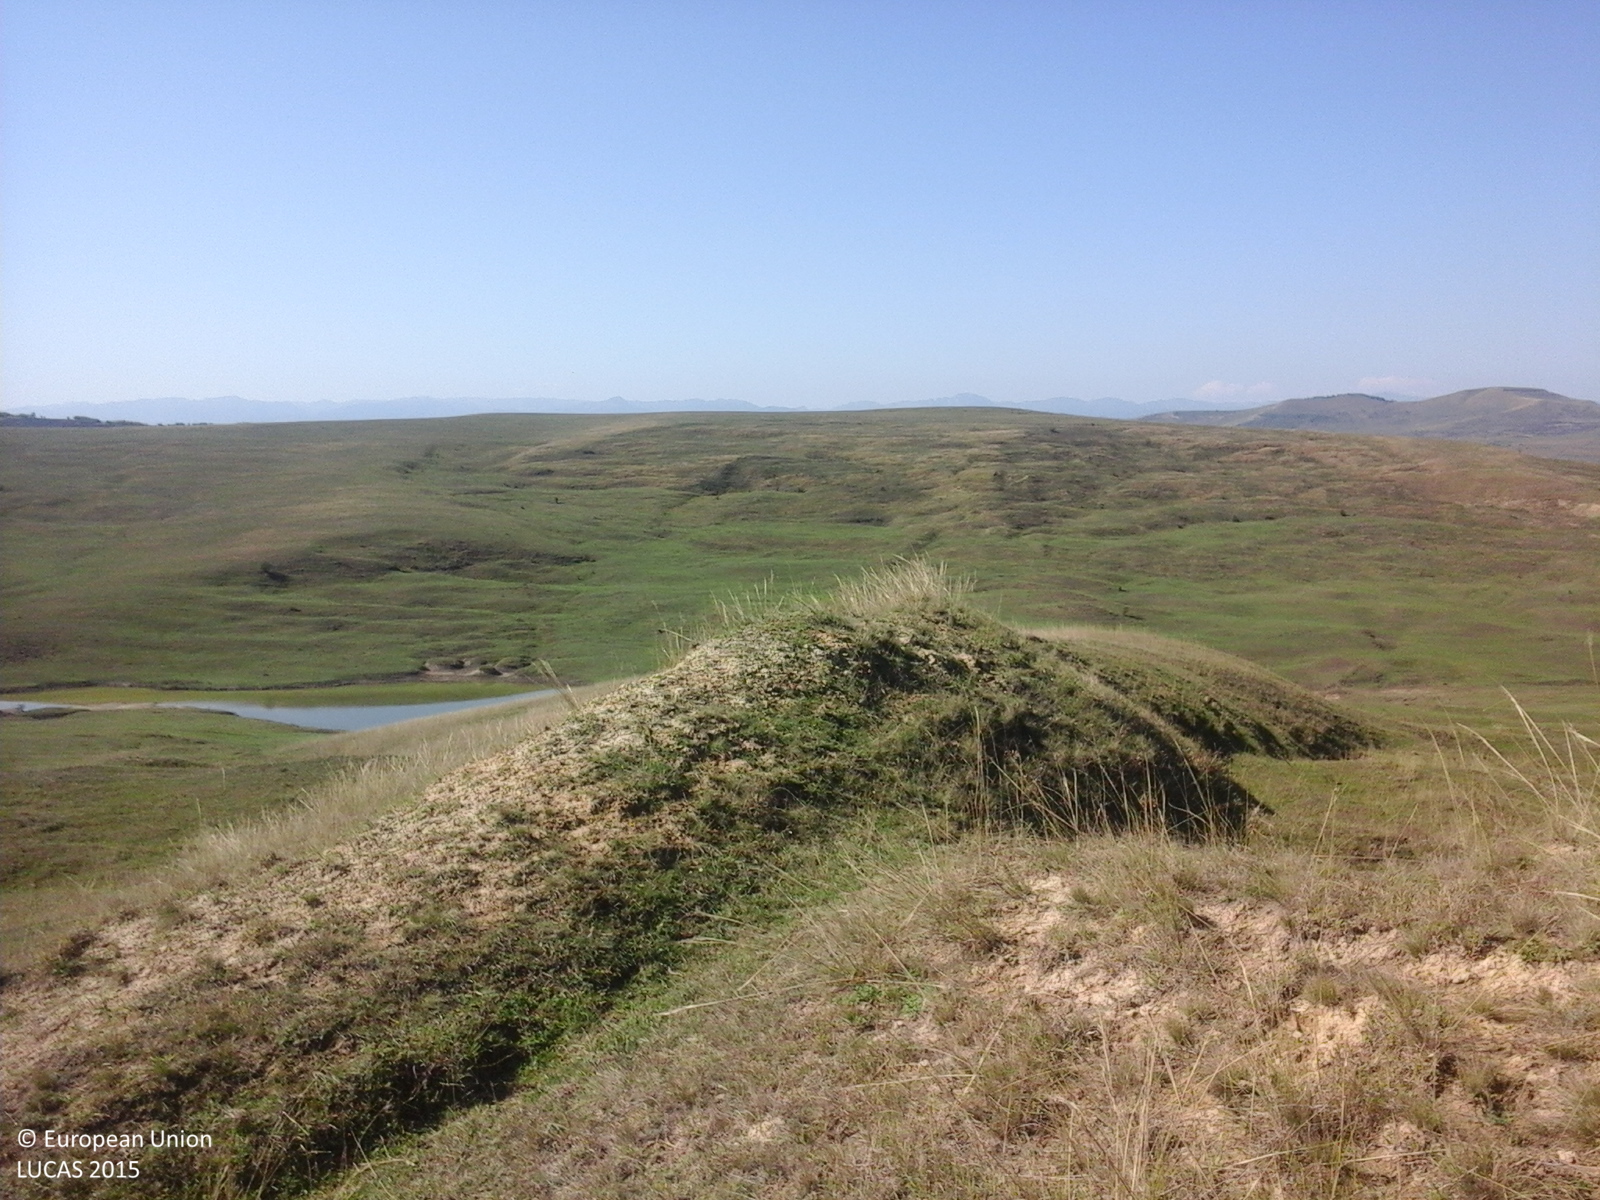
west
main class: Grassland
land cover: Grassland without tree/shrub cover
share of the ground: > 75 %
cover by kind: herbaceous plants 100 %
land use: Agriculture (excluding fallow land and kitchen gardens)
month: October
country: RO
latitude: 46.1623
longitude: 23.8114
